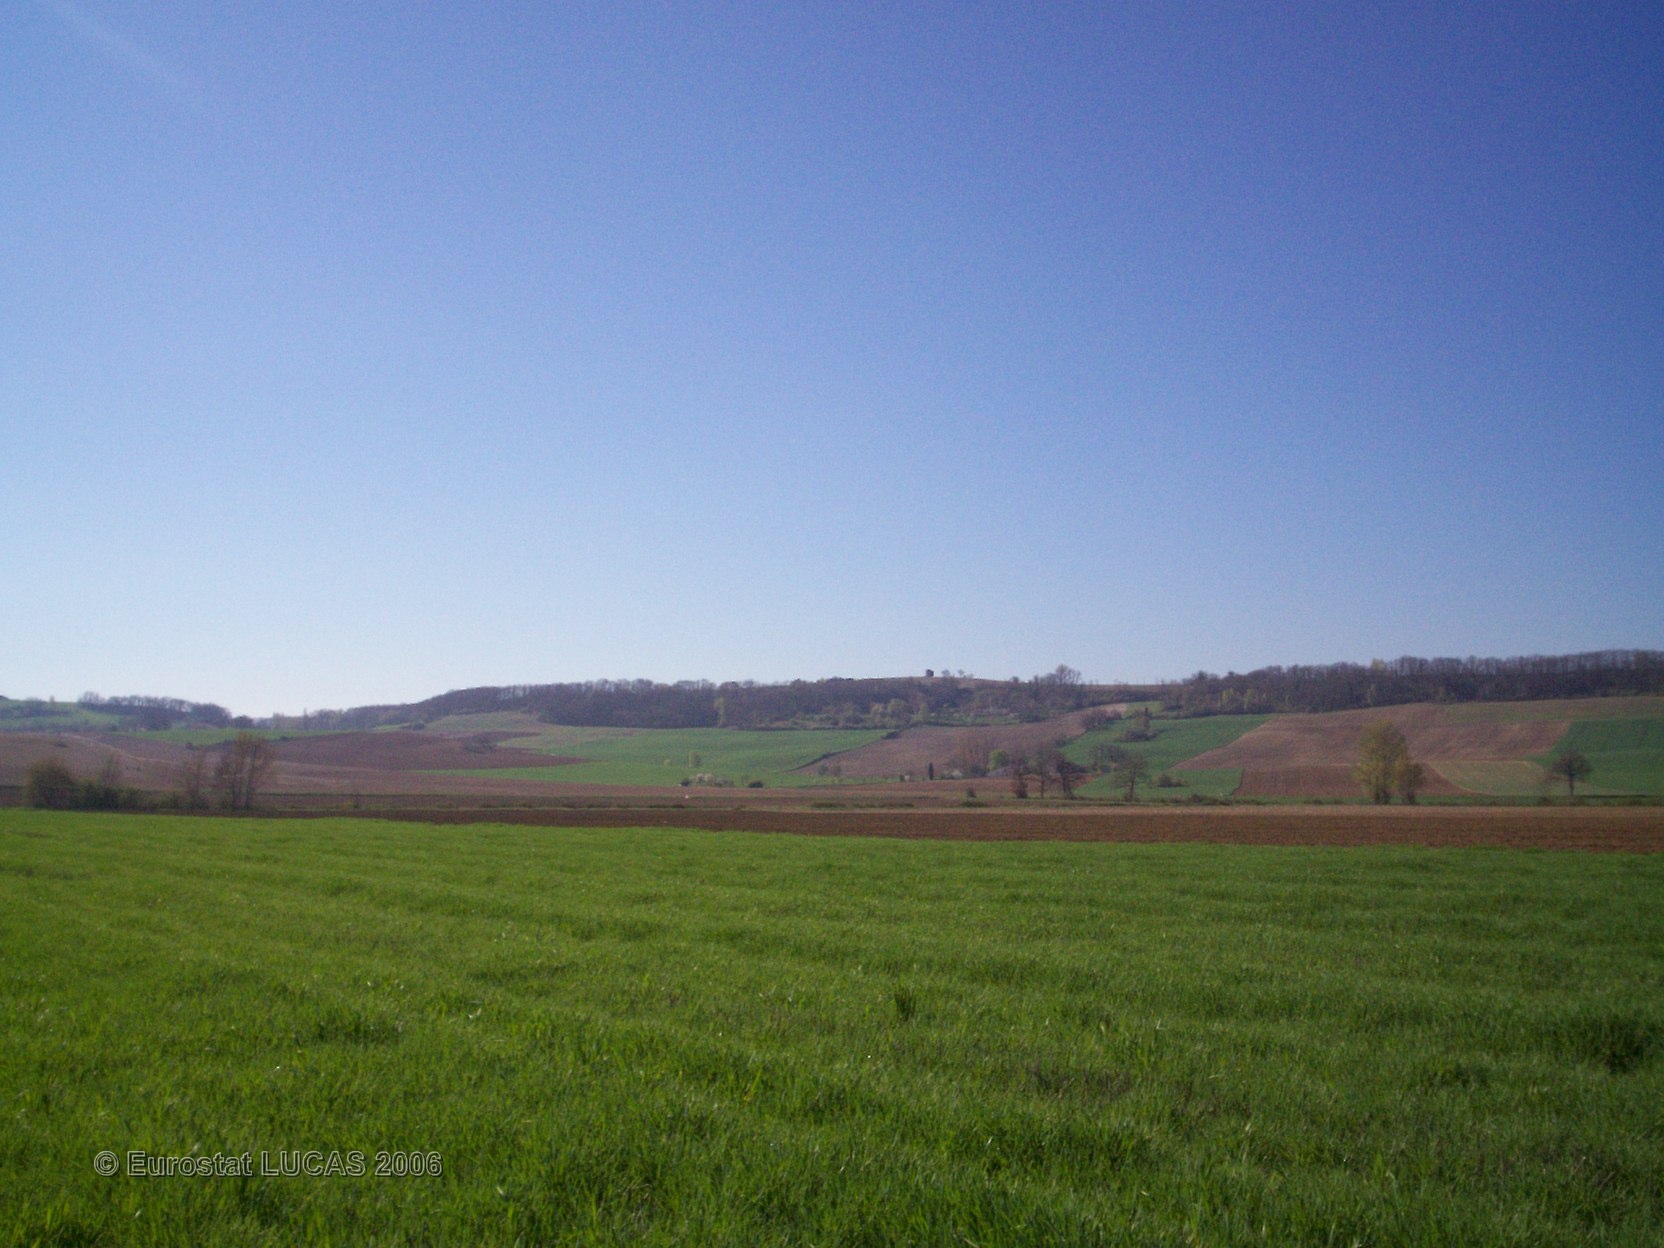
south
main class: Cropland
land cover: Barley
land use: Agriculture (excluding fallow land and kitchen gardens)
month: April
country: FR
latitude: 43.9582
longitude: 0.7876
